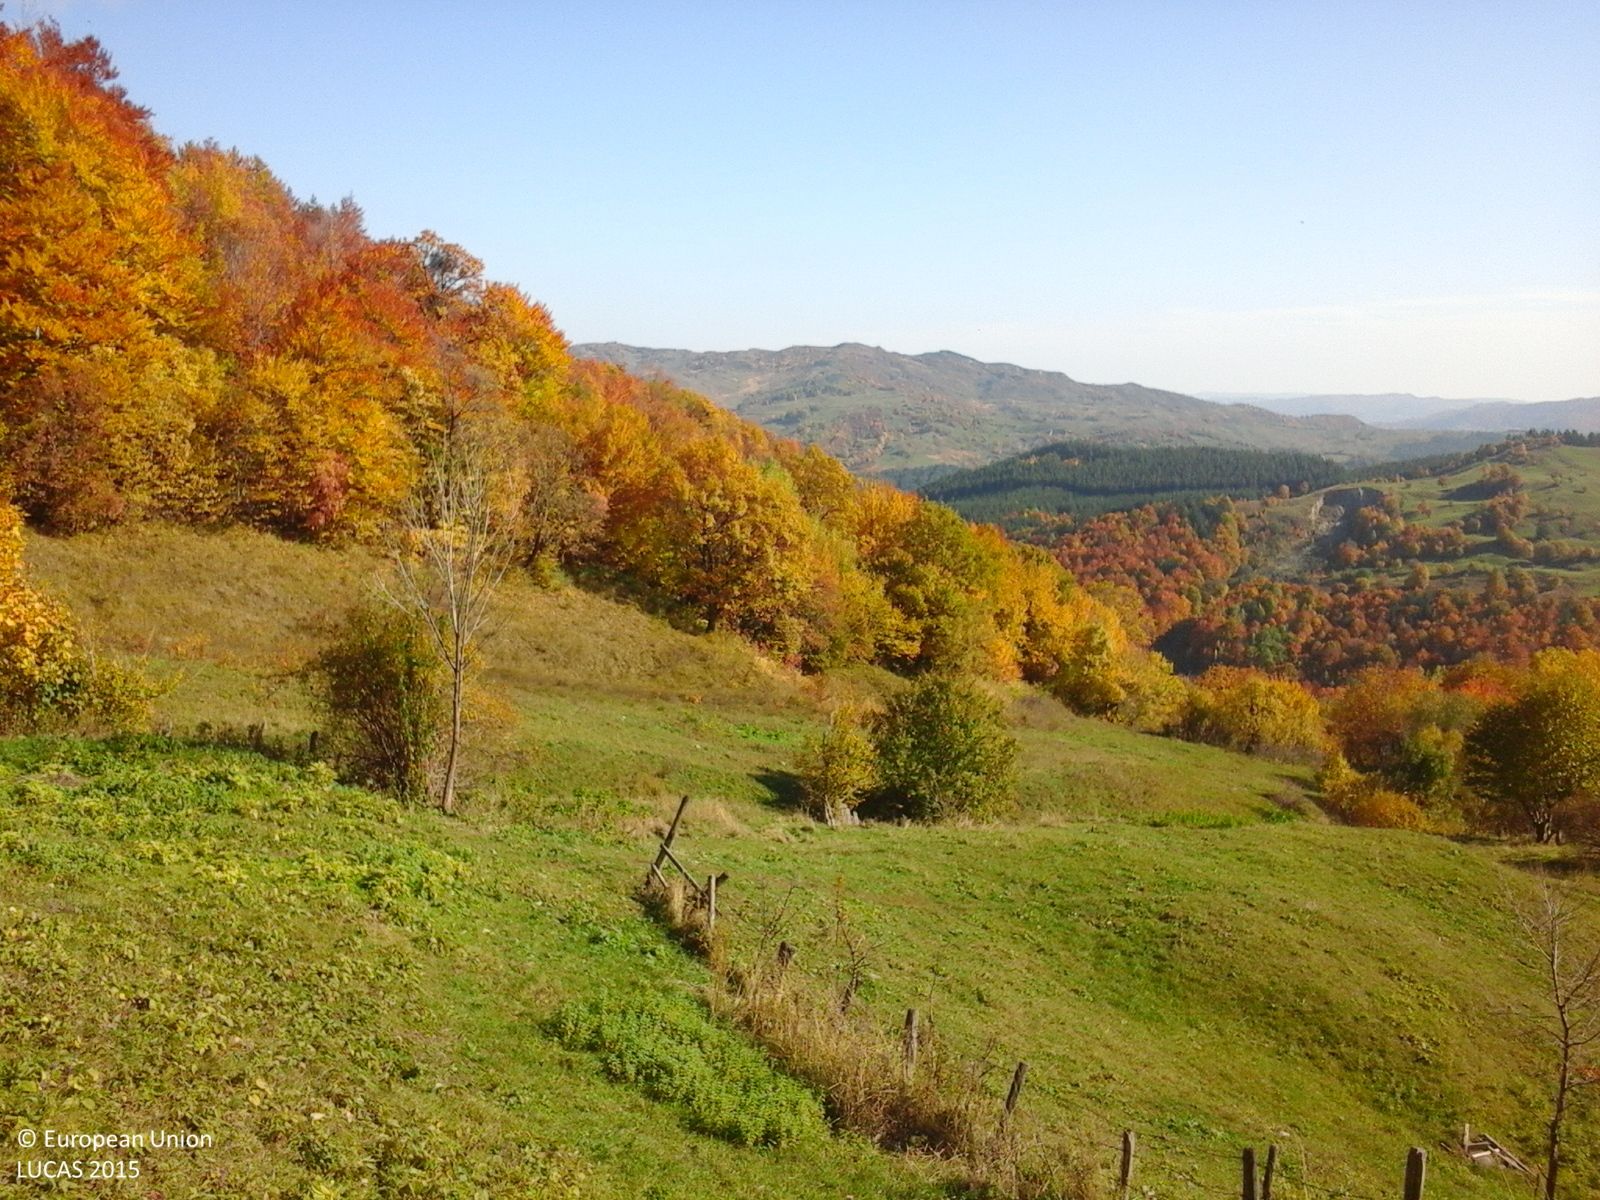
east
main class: Grassland
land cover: Grassland without tree/shrub cover
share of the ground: > 75 %
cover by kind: herbaceous plants 100 %
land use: Agriculture (excluding fallow land and kitchen gardens)
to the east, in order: Grassland without tree/shrub cover; Fences; Grassland without tree/shrub cover; Grassland with sparse tree/shrub cover; Fences; Broadleaved woodland
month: October
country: RO
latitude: 45.5195
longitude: 26.6047
